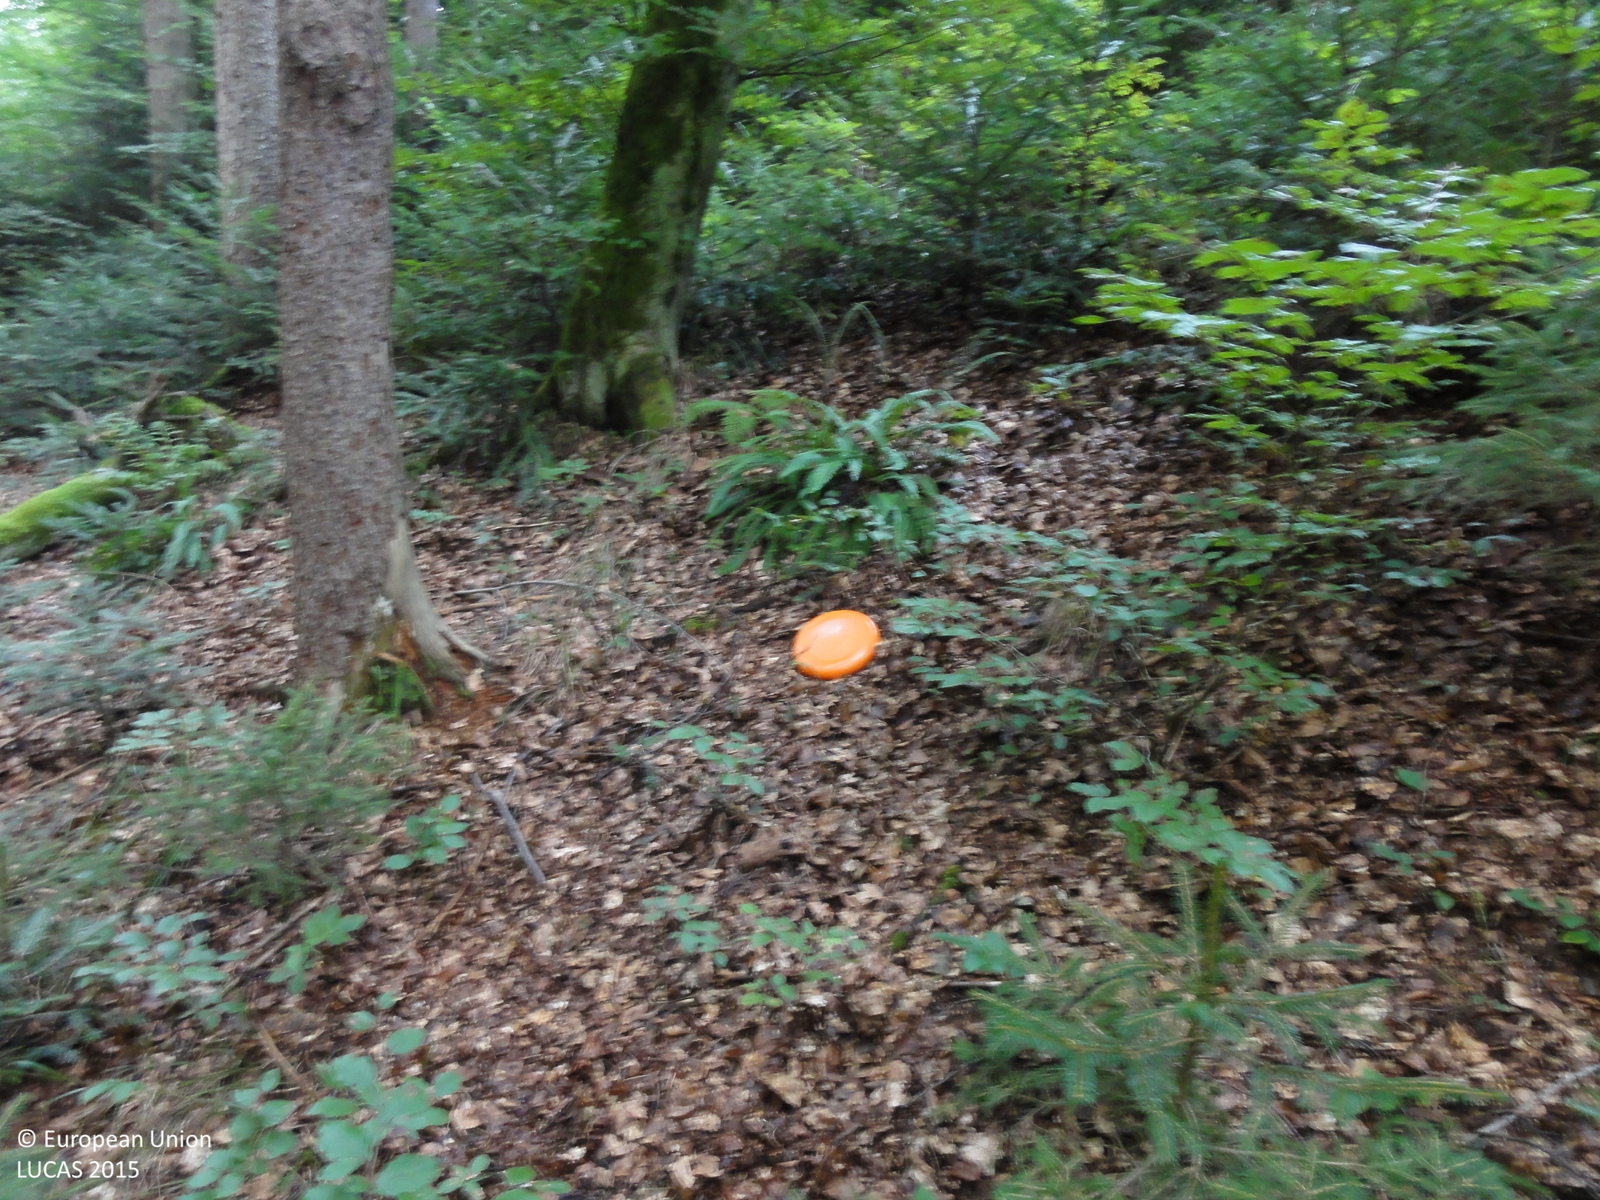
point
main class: Woodland
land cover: Spruce dominated mixed woodland
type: mountainous beech forest
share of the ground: > 75 %
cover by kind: broadleaved forest trees 60 %, coniferous forest trees 30 %, shrubs 5 %, unconsolidated bare surface 5 %
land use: Forestry
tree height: > 5 m
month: August
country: SI
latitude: 46.0790
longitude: 14.8459
